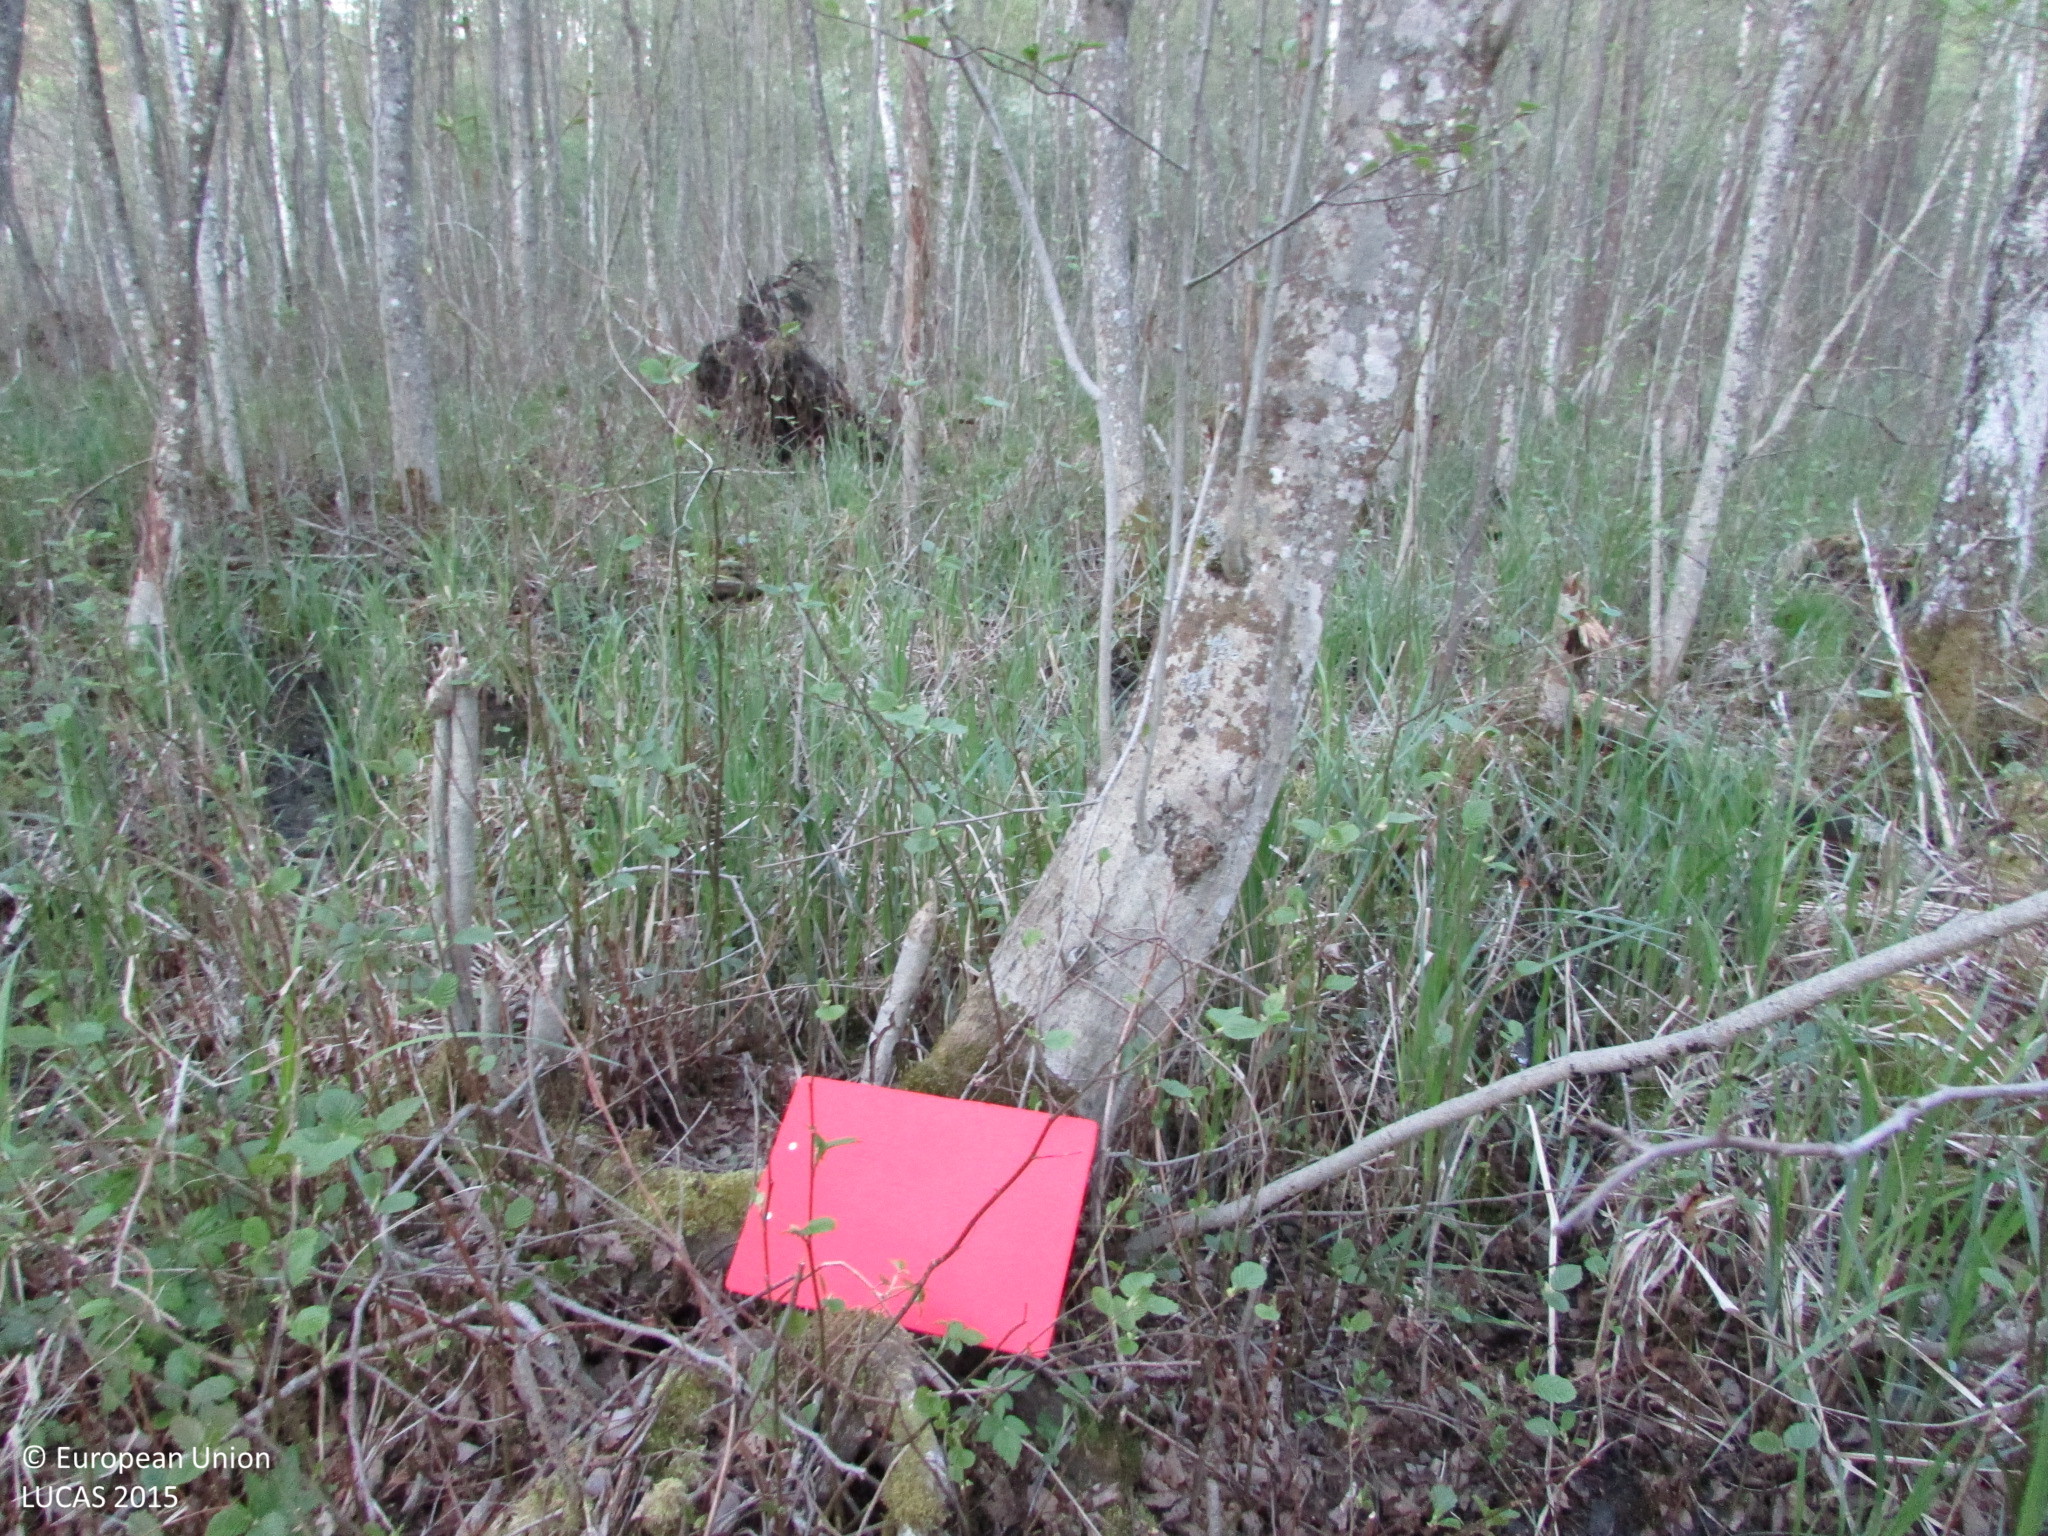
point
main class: Woodland
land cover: Broadleaved woodland
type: floodplain forest
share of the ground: > 75 %
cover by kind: broadleaved forest trees 80 %, herbaceous plants 10 %, shrubs 5 %
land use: Forestry
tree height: > 5 m
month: May
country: LV
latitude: 55.8758
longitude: 27.3597
